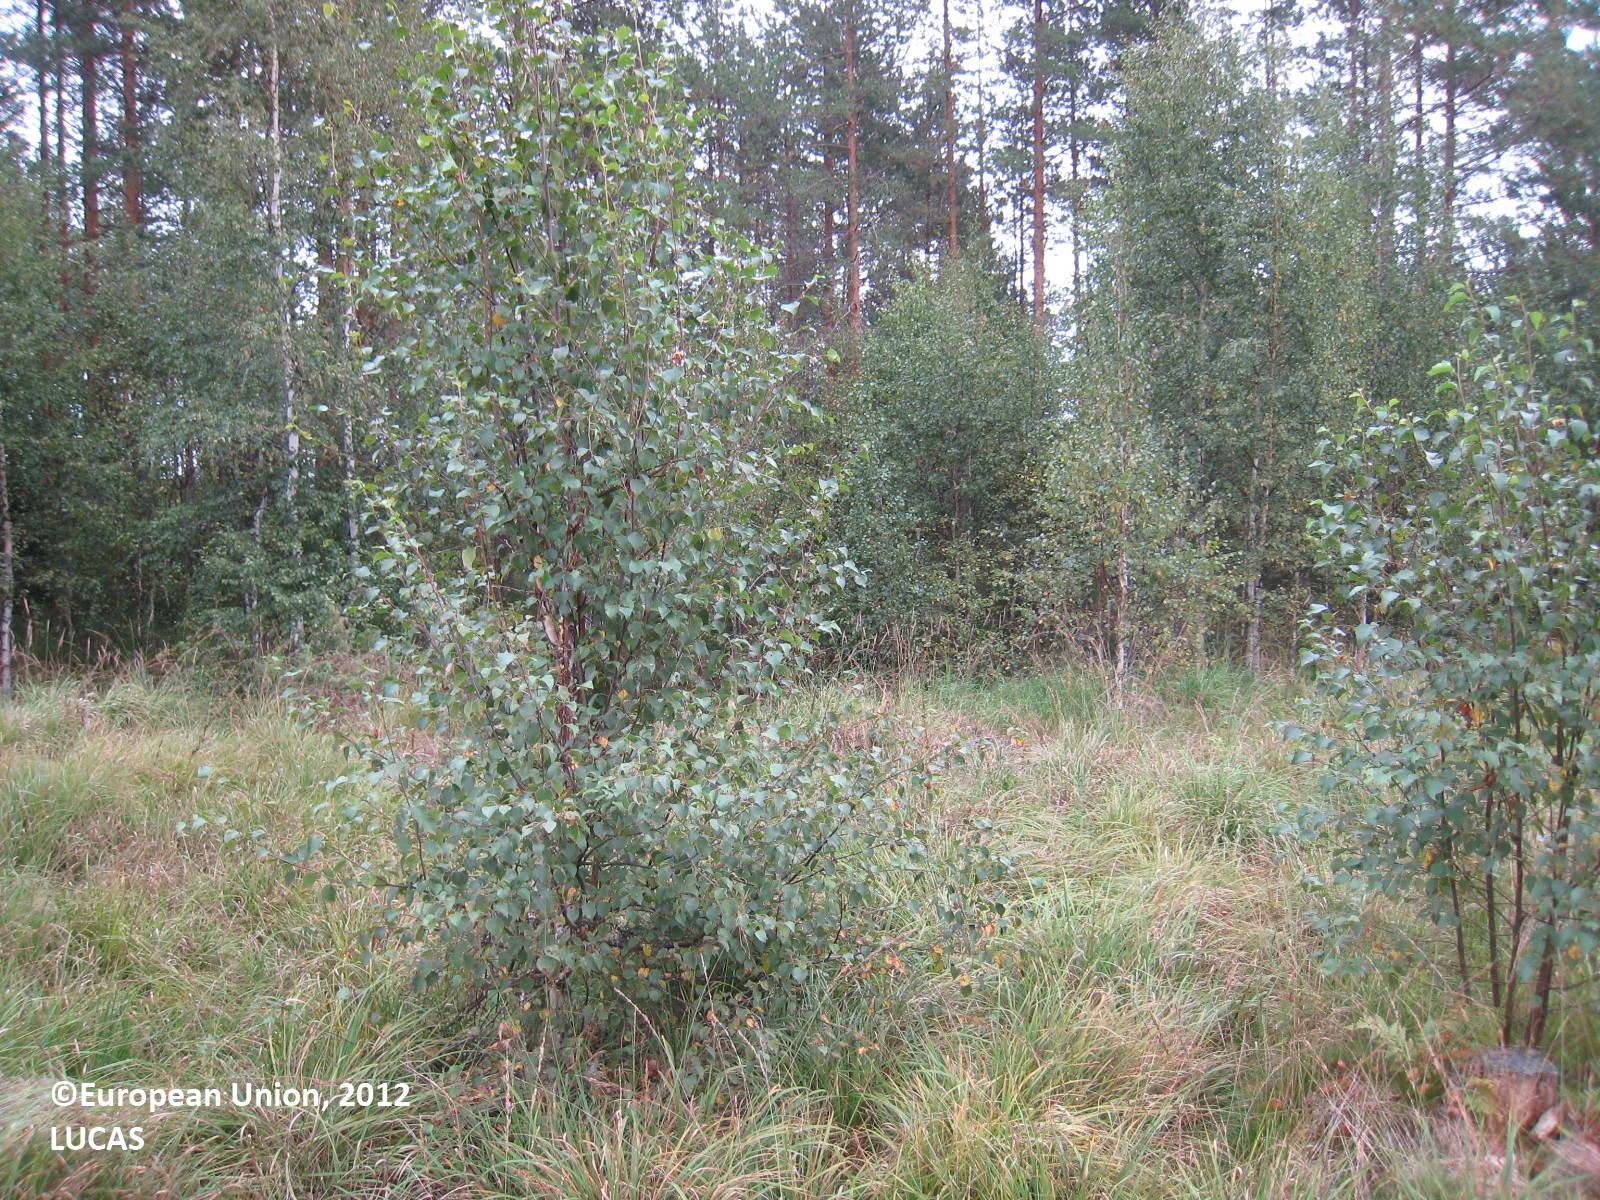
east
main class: Grassland
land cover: Grassland with sparse tree/shrub cover
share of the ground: > 75 %
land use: Forestry
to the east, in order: Grassland with sparse tree/shrub cover; Ditches and canals; Pine dominated mixed woodland; Pine dominated coniferous woodland; Ditches and canals; Pine dominated coniferous woodland; Ditches and canals; Pine dominated coniferous woodland
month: August
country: FI
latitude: 61.8548
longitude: 26.0373
